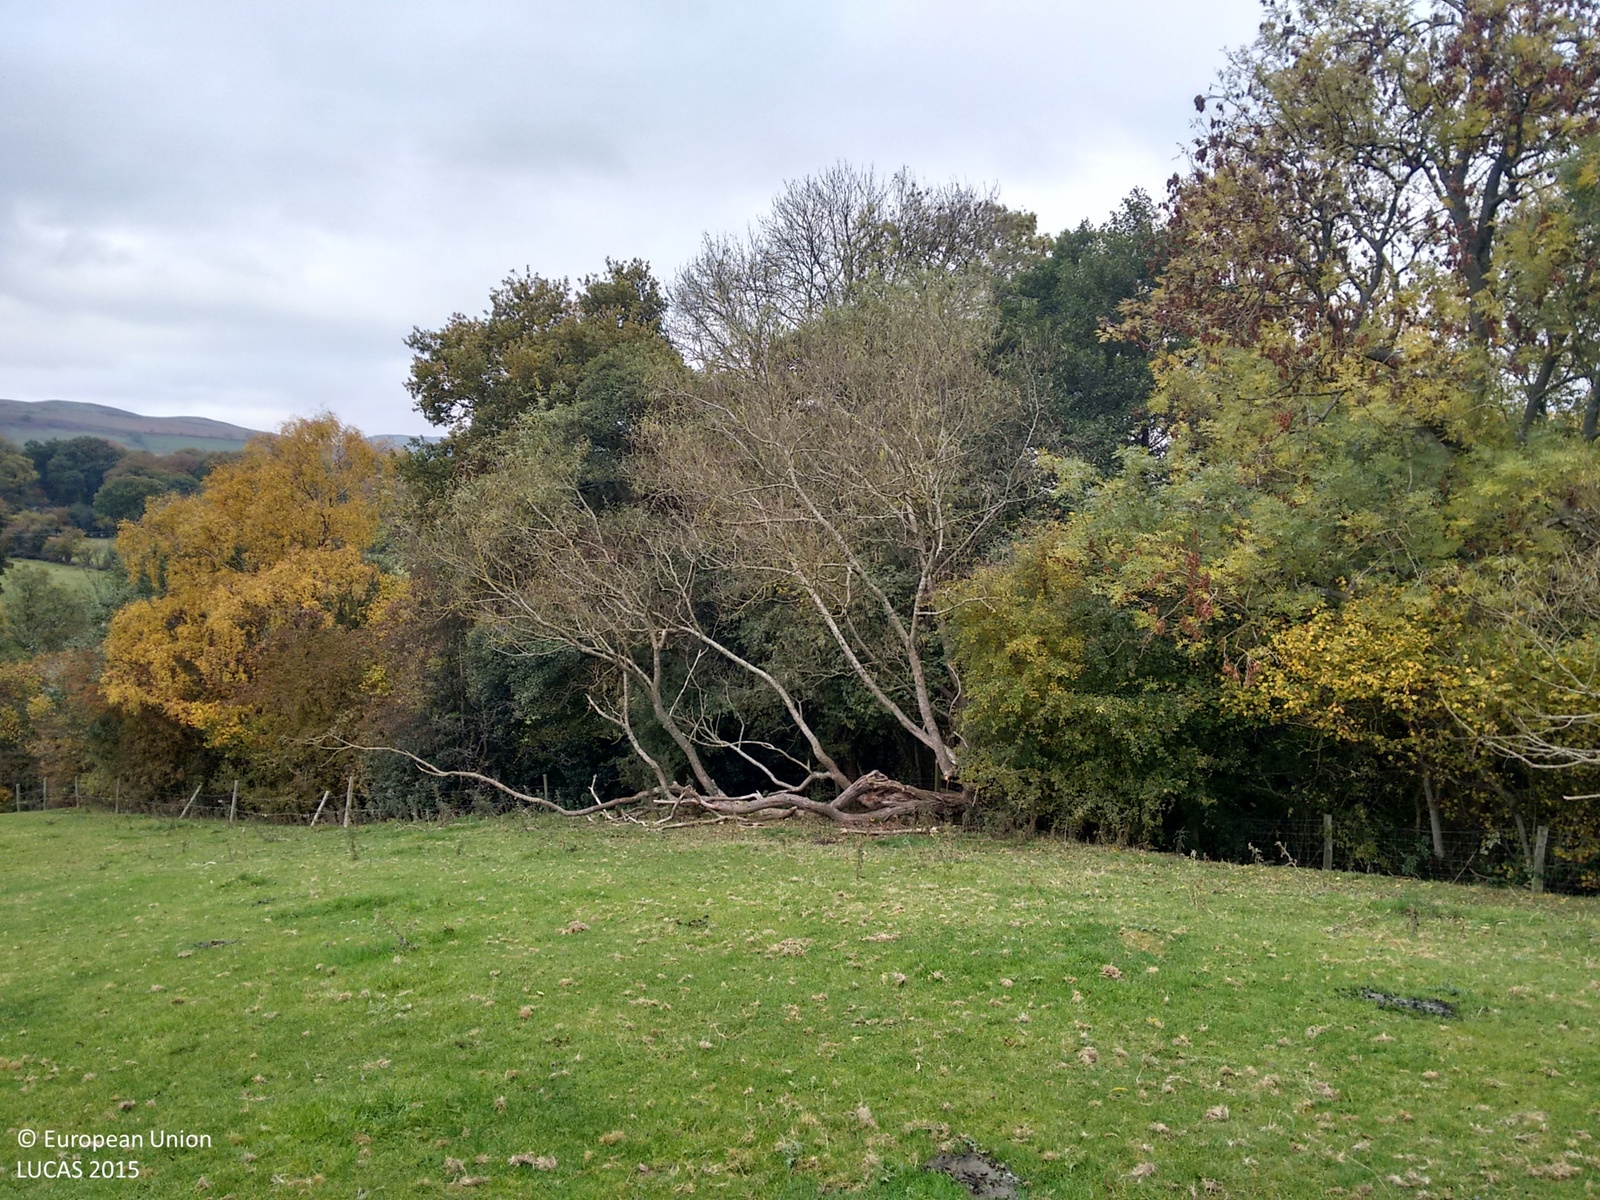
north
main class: Grassland
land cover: Grassland without tree/shrub cover
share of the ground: > 75 %
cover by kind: herbaceous plants 100 %
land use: Agriculture (excluding fallow land and kitchen gardens)
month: October
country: GB
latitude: 52.4959
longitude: -2.8426
